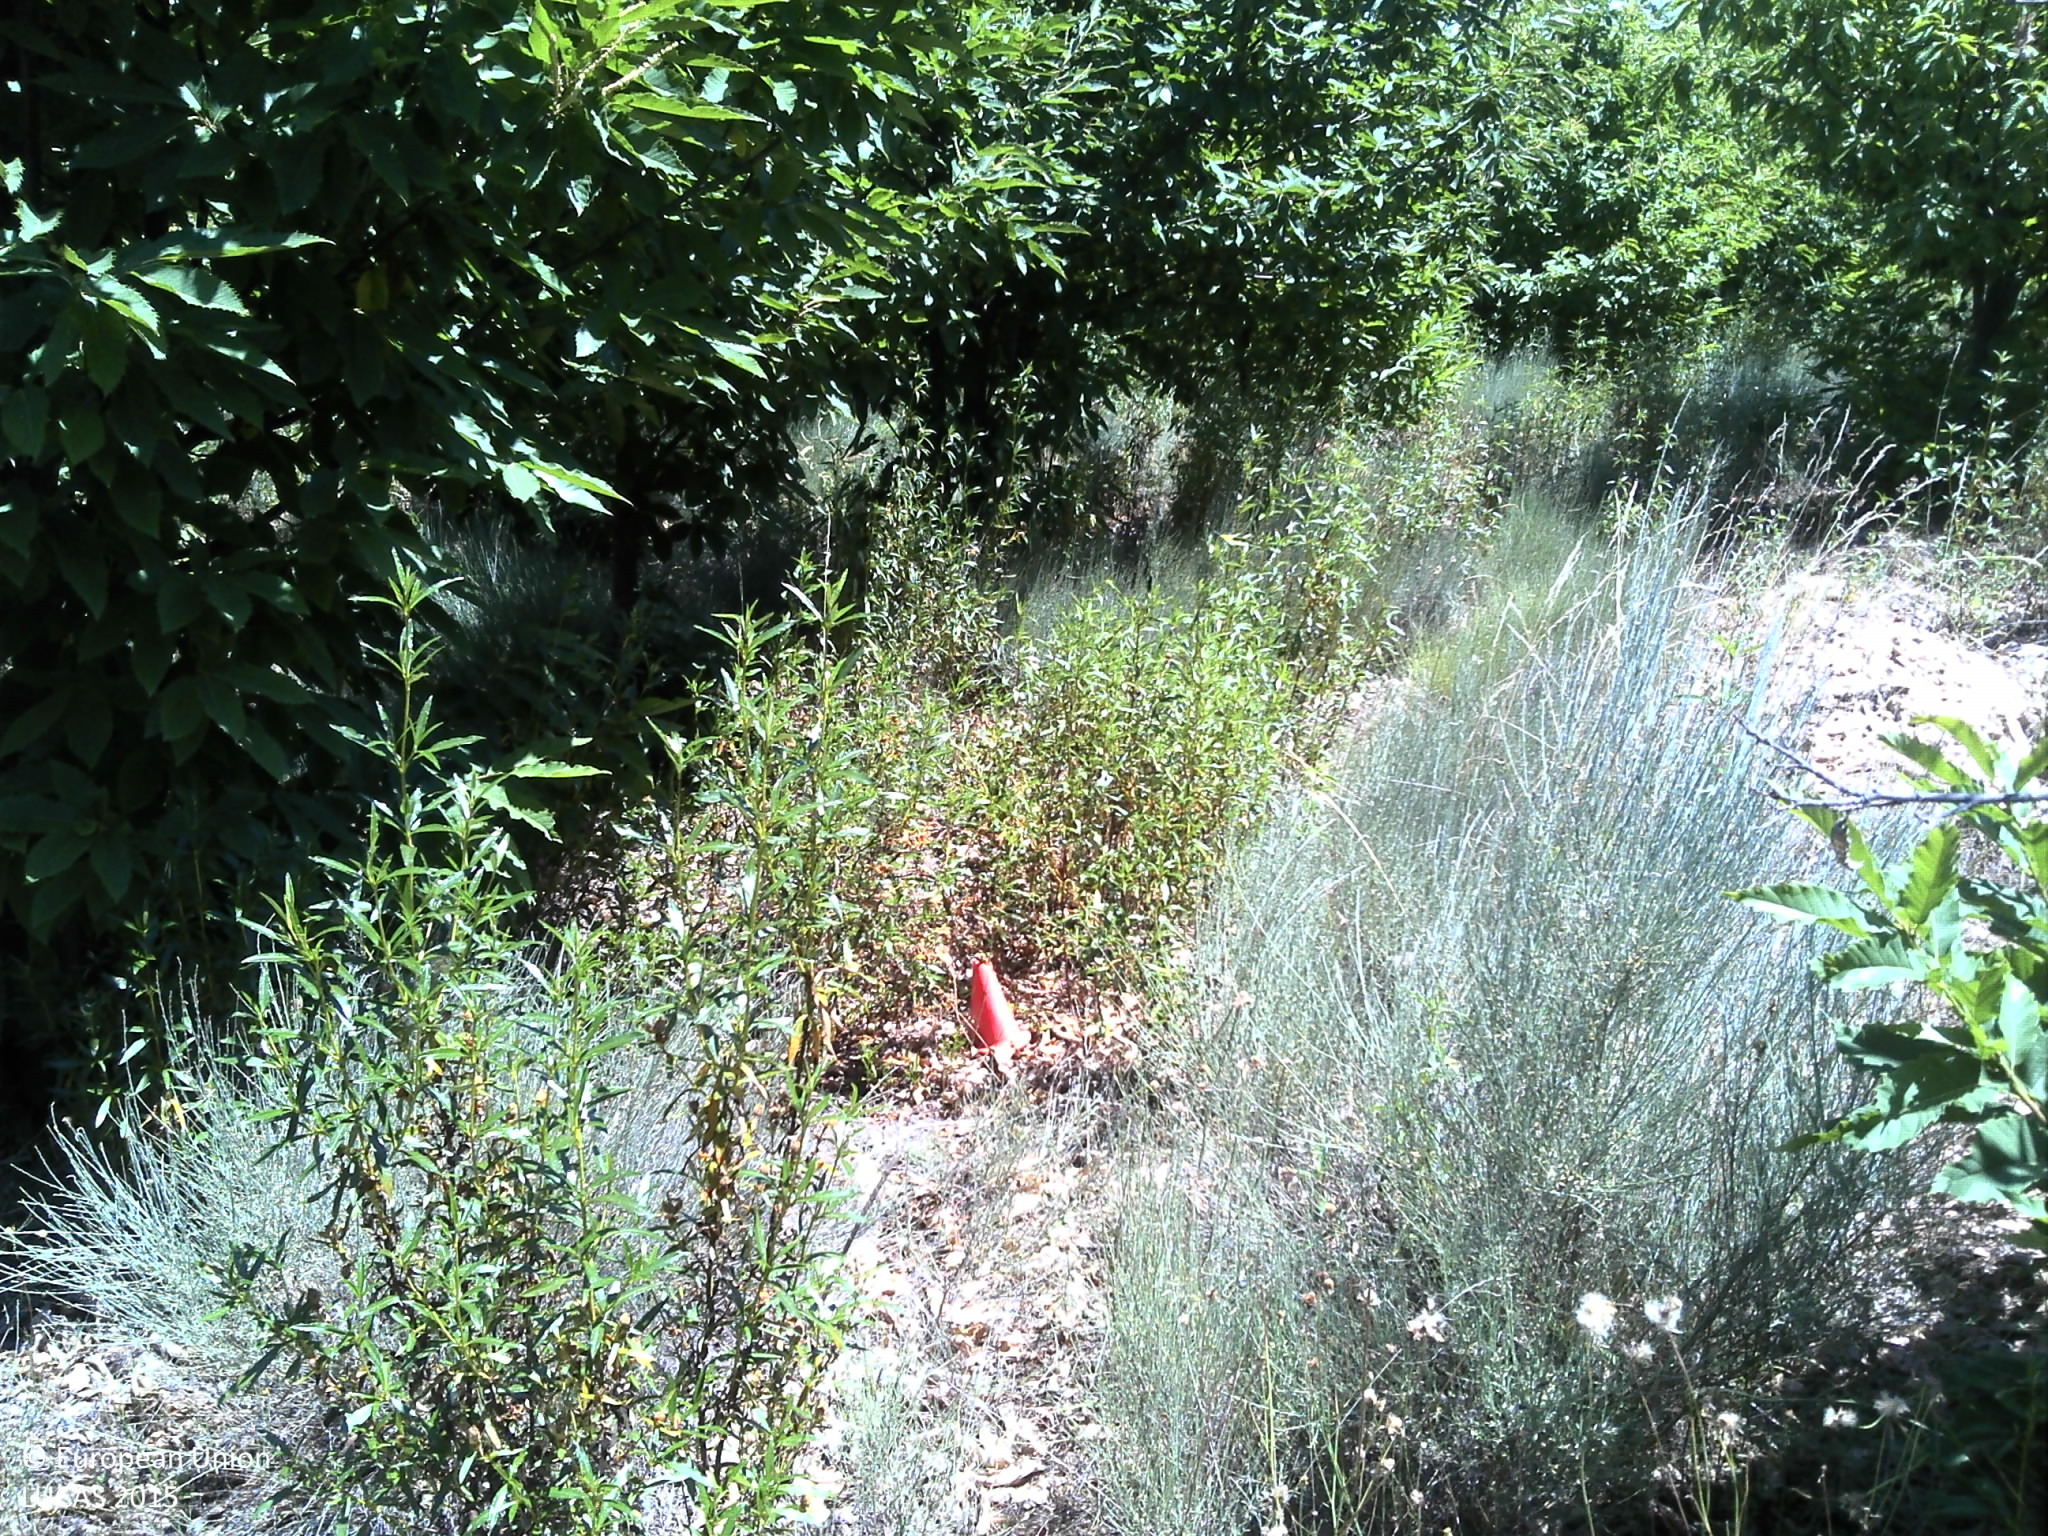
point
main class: Woodland
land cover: Broadleaved woodland
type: thermophilous deciduous forest
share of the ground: 10 - 25 %
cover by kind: shrubs 80 %, broadleaved forest trees 20 %
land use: Forestry
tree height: < 5 m
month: June
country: PT
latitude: 41.0489
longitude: -6.9409
